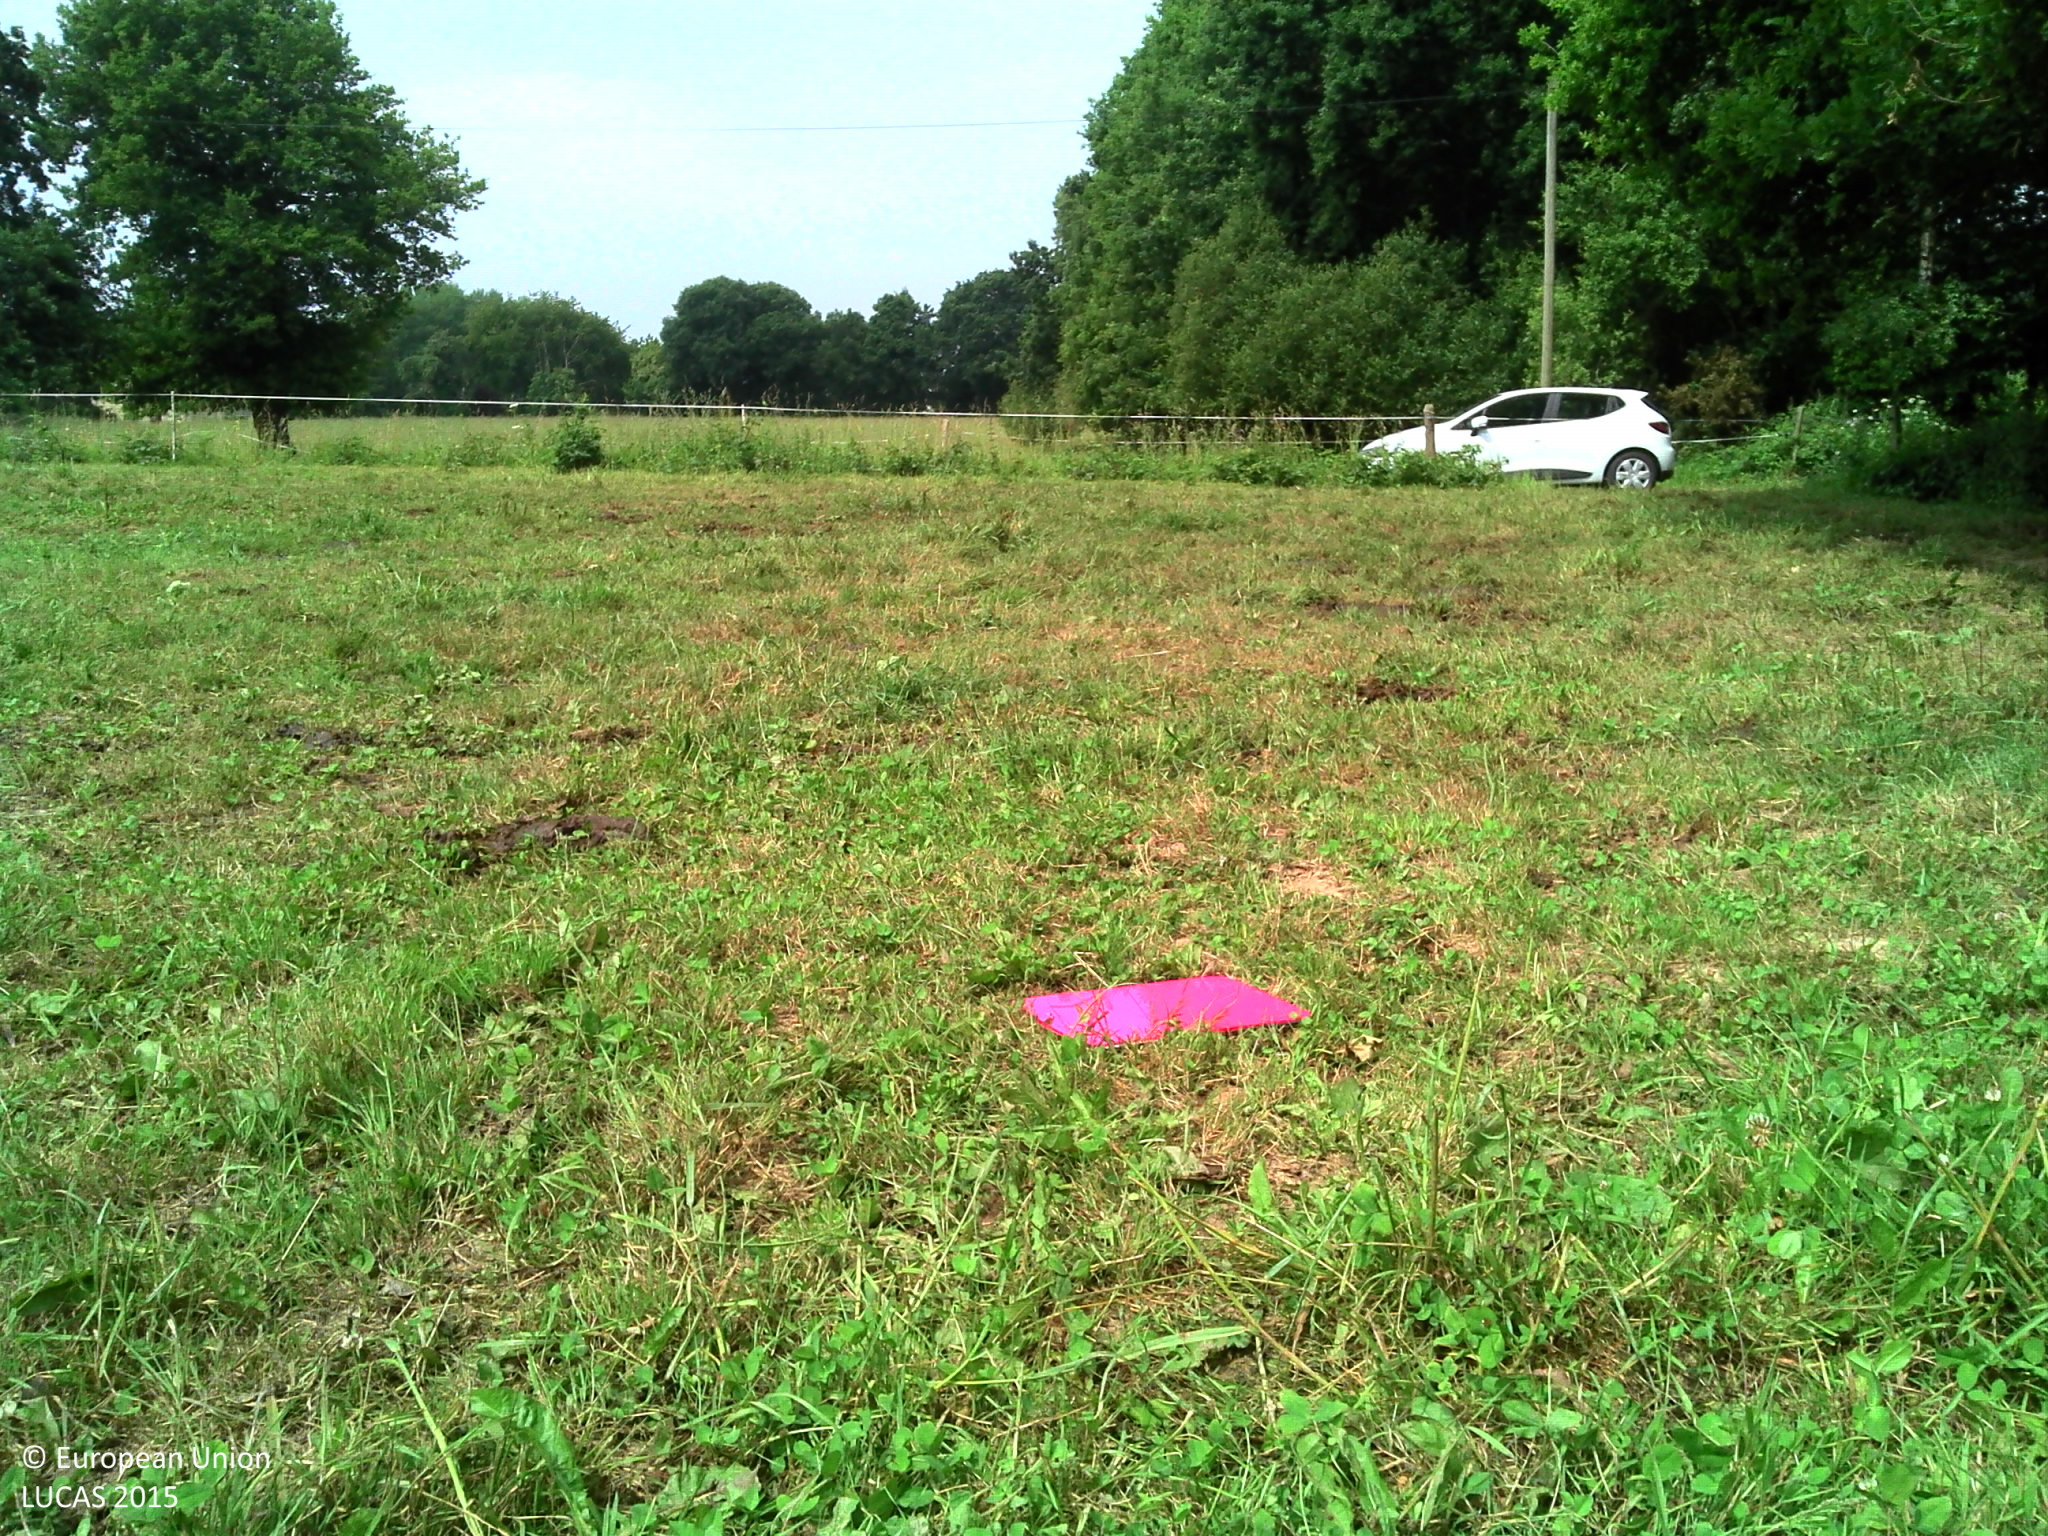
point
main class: Grassland
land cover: Grassland without tree/shrub cover
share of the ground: > 75 %
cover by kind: herbaceous plants 100 %
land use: Agriculture (excluding fallow land and kitchen gardens)
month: June
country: FR
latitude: 48.1503
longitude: -2.1387
